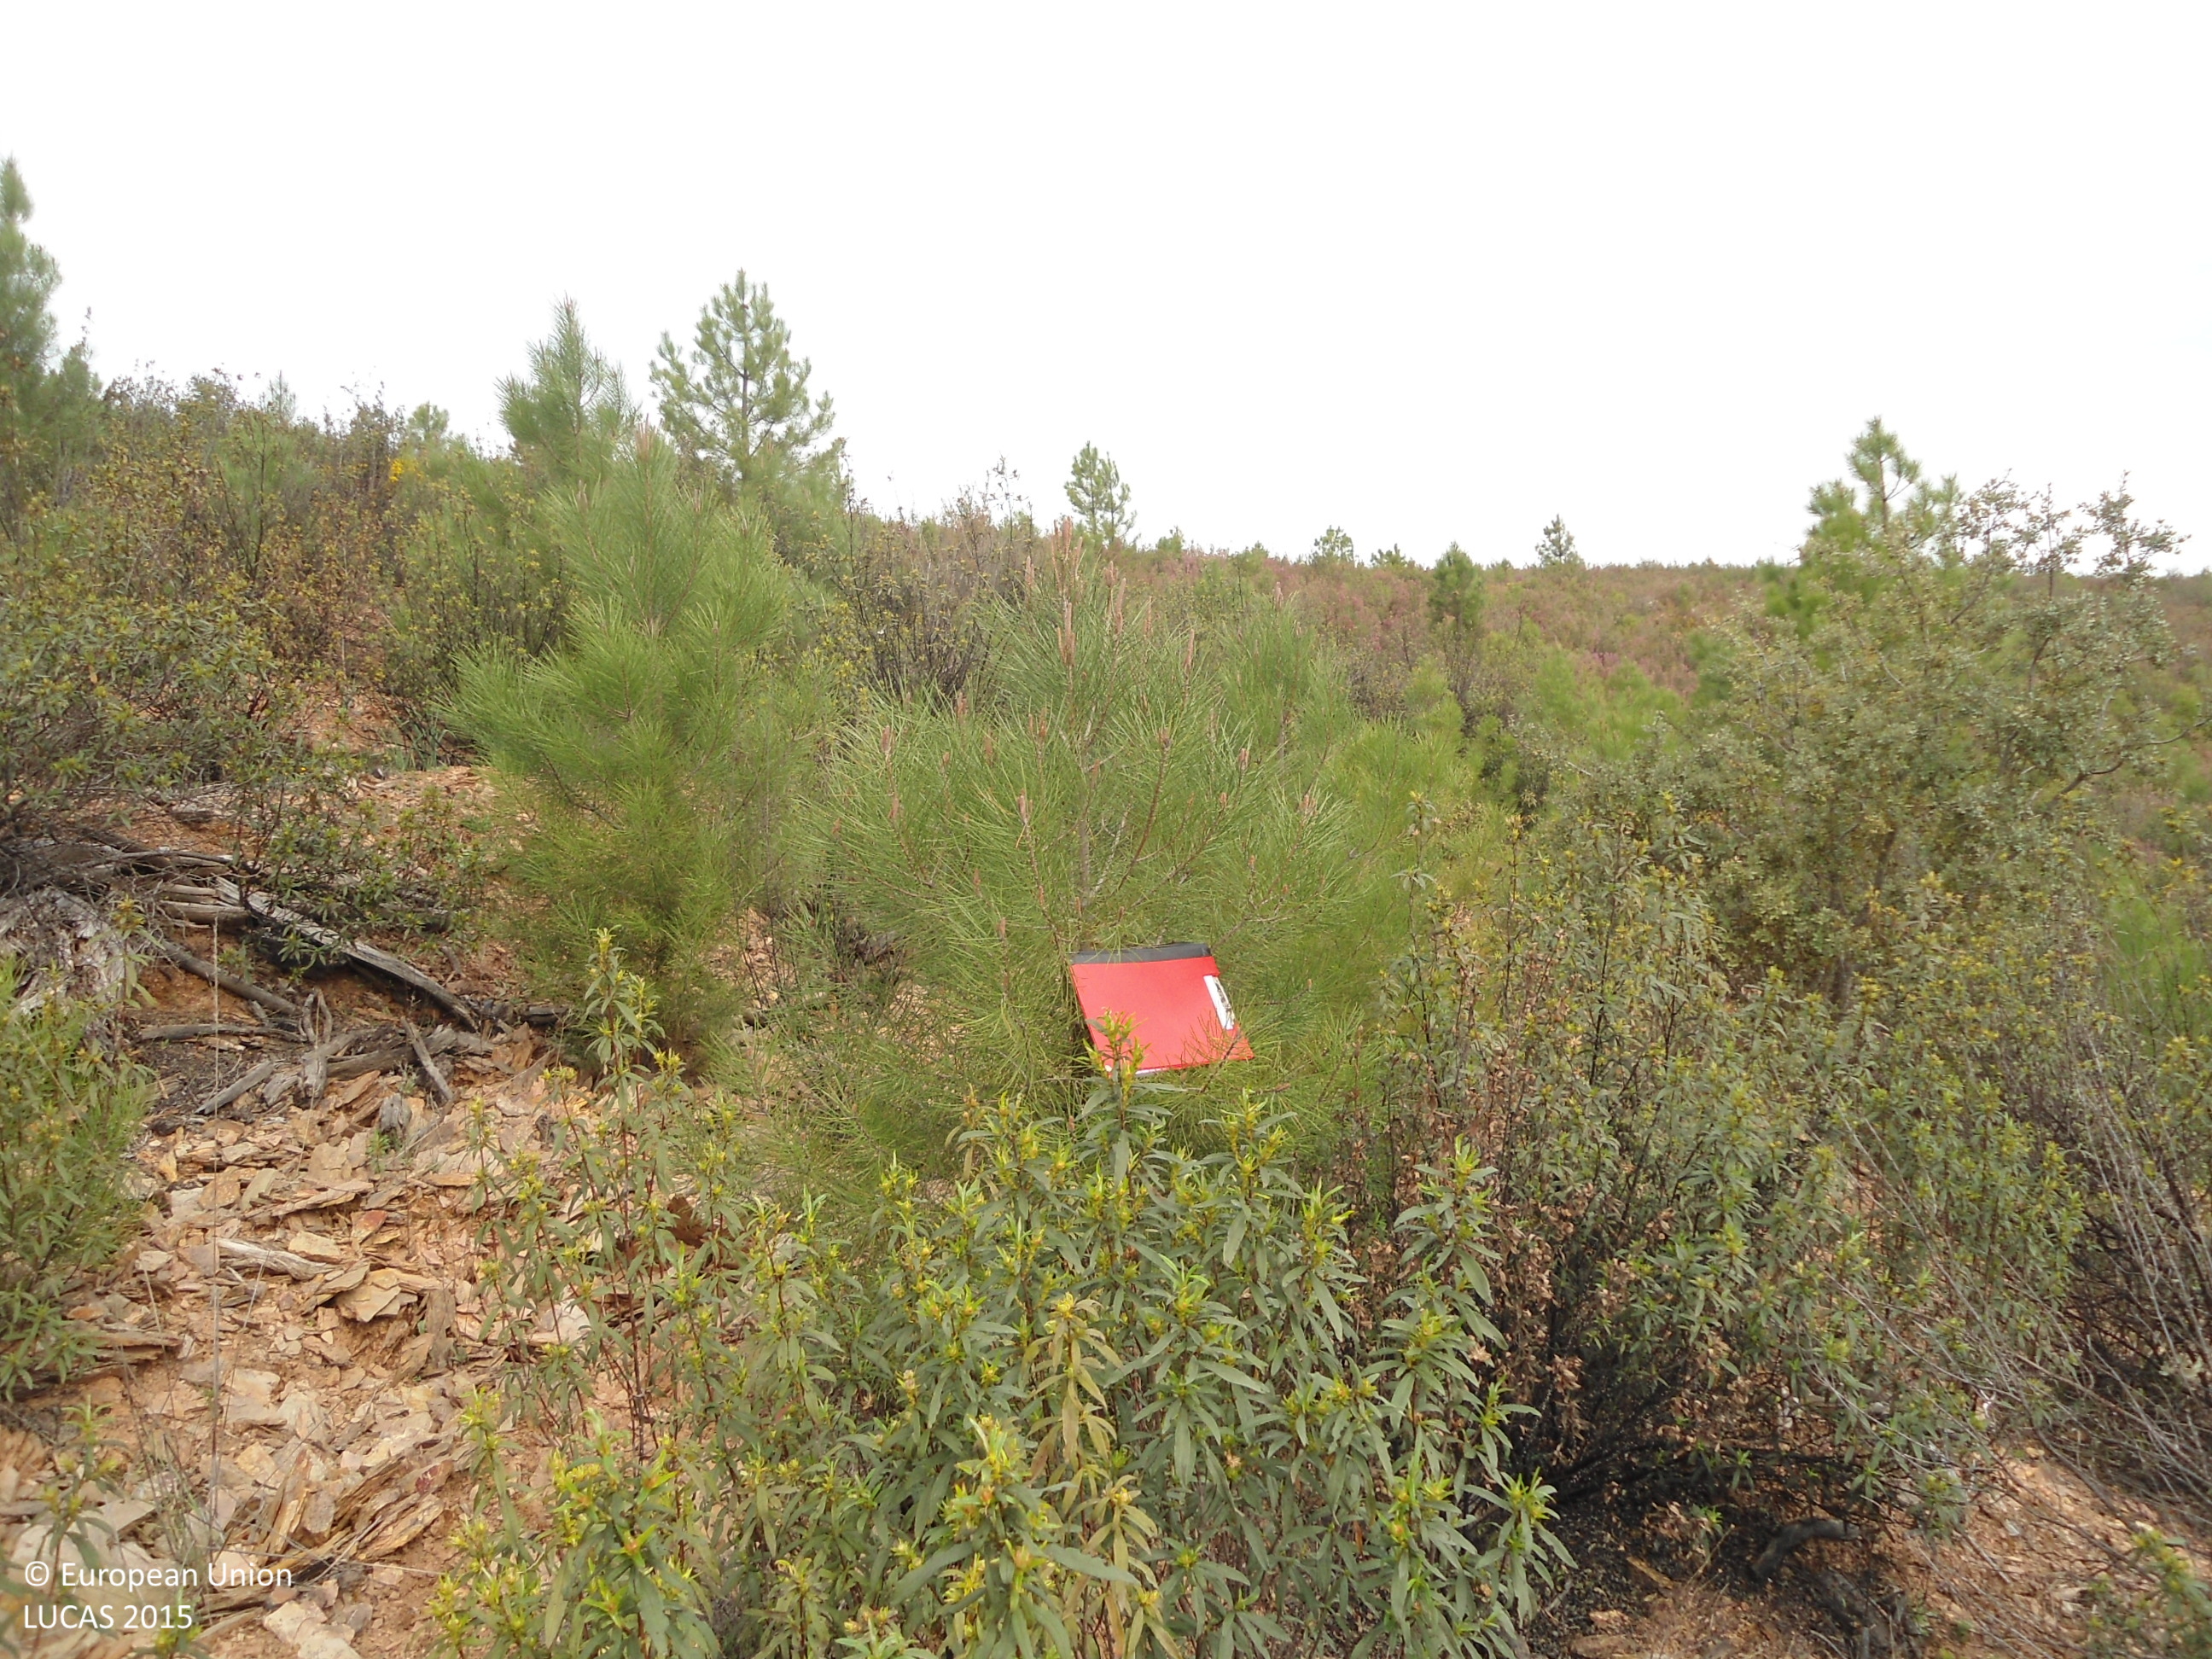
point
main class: Woodland
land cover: Pine dominated coniferous woodland
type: coniferous forest of the mediterranean region
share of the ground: 50 - 75 %
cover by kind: coniferous forest trees 50 %, shrubs 50 %
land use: Forestry
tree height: < 5 m
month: April
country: ES
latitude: 41.8029
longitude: -6.5120
